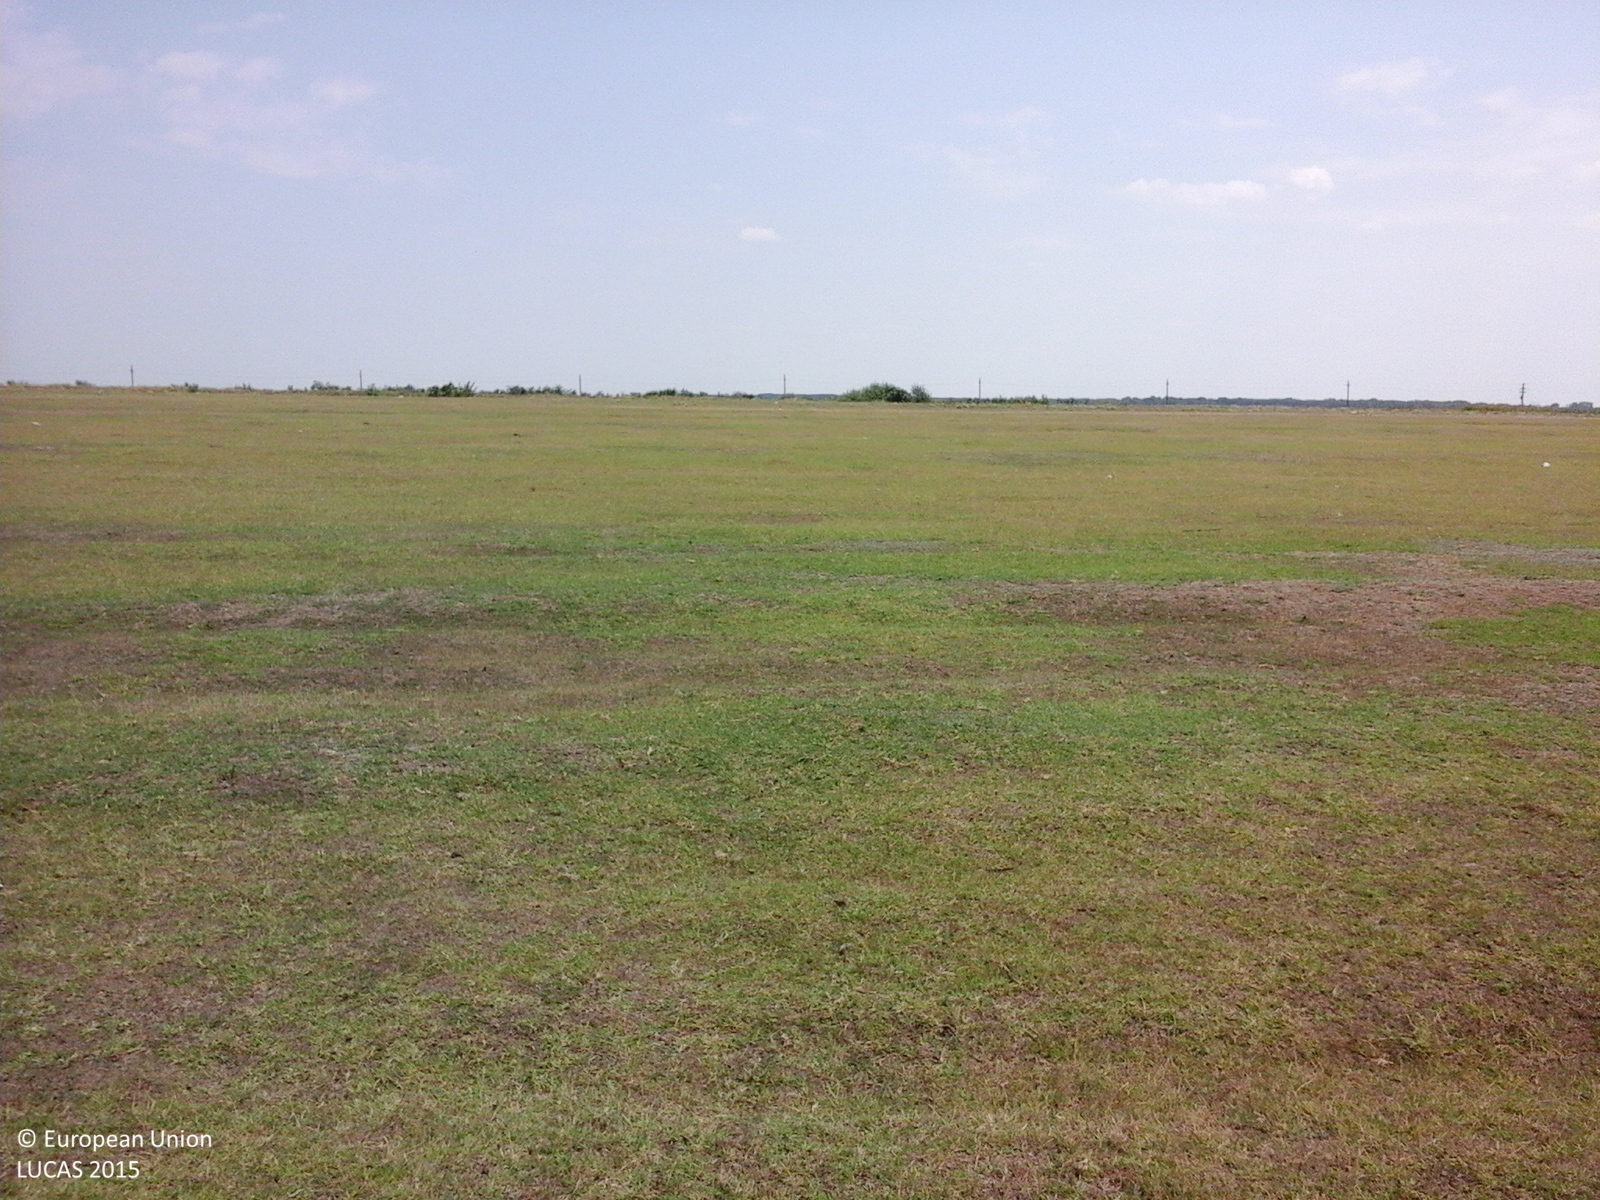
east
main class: Grassland
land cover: Grassland without tree/shrub cover
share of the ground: > 75 %
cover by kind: herbaceous plants 100 %
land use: Agriculture (excluding fallow land and kitchen gardens)
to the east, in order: Grassland without tree/shrub cover; Ditches and canals; Tracks; Other fresh vegetables
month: July
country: RO
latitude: 44.4440
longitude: 27.5461
